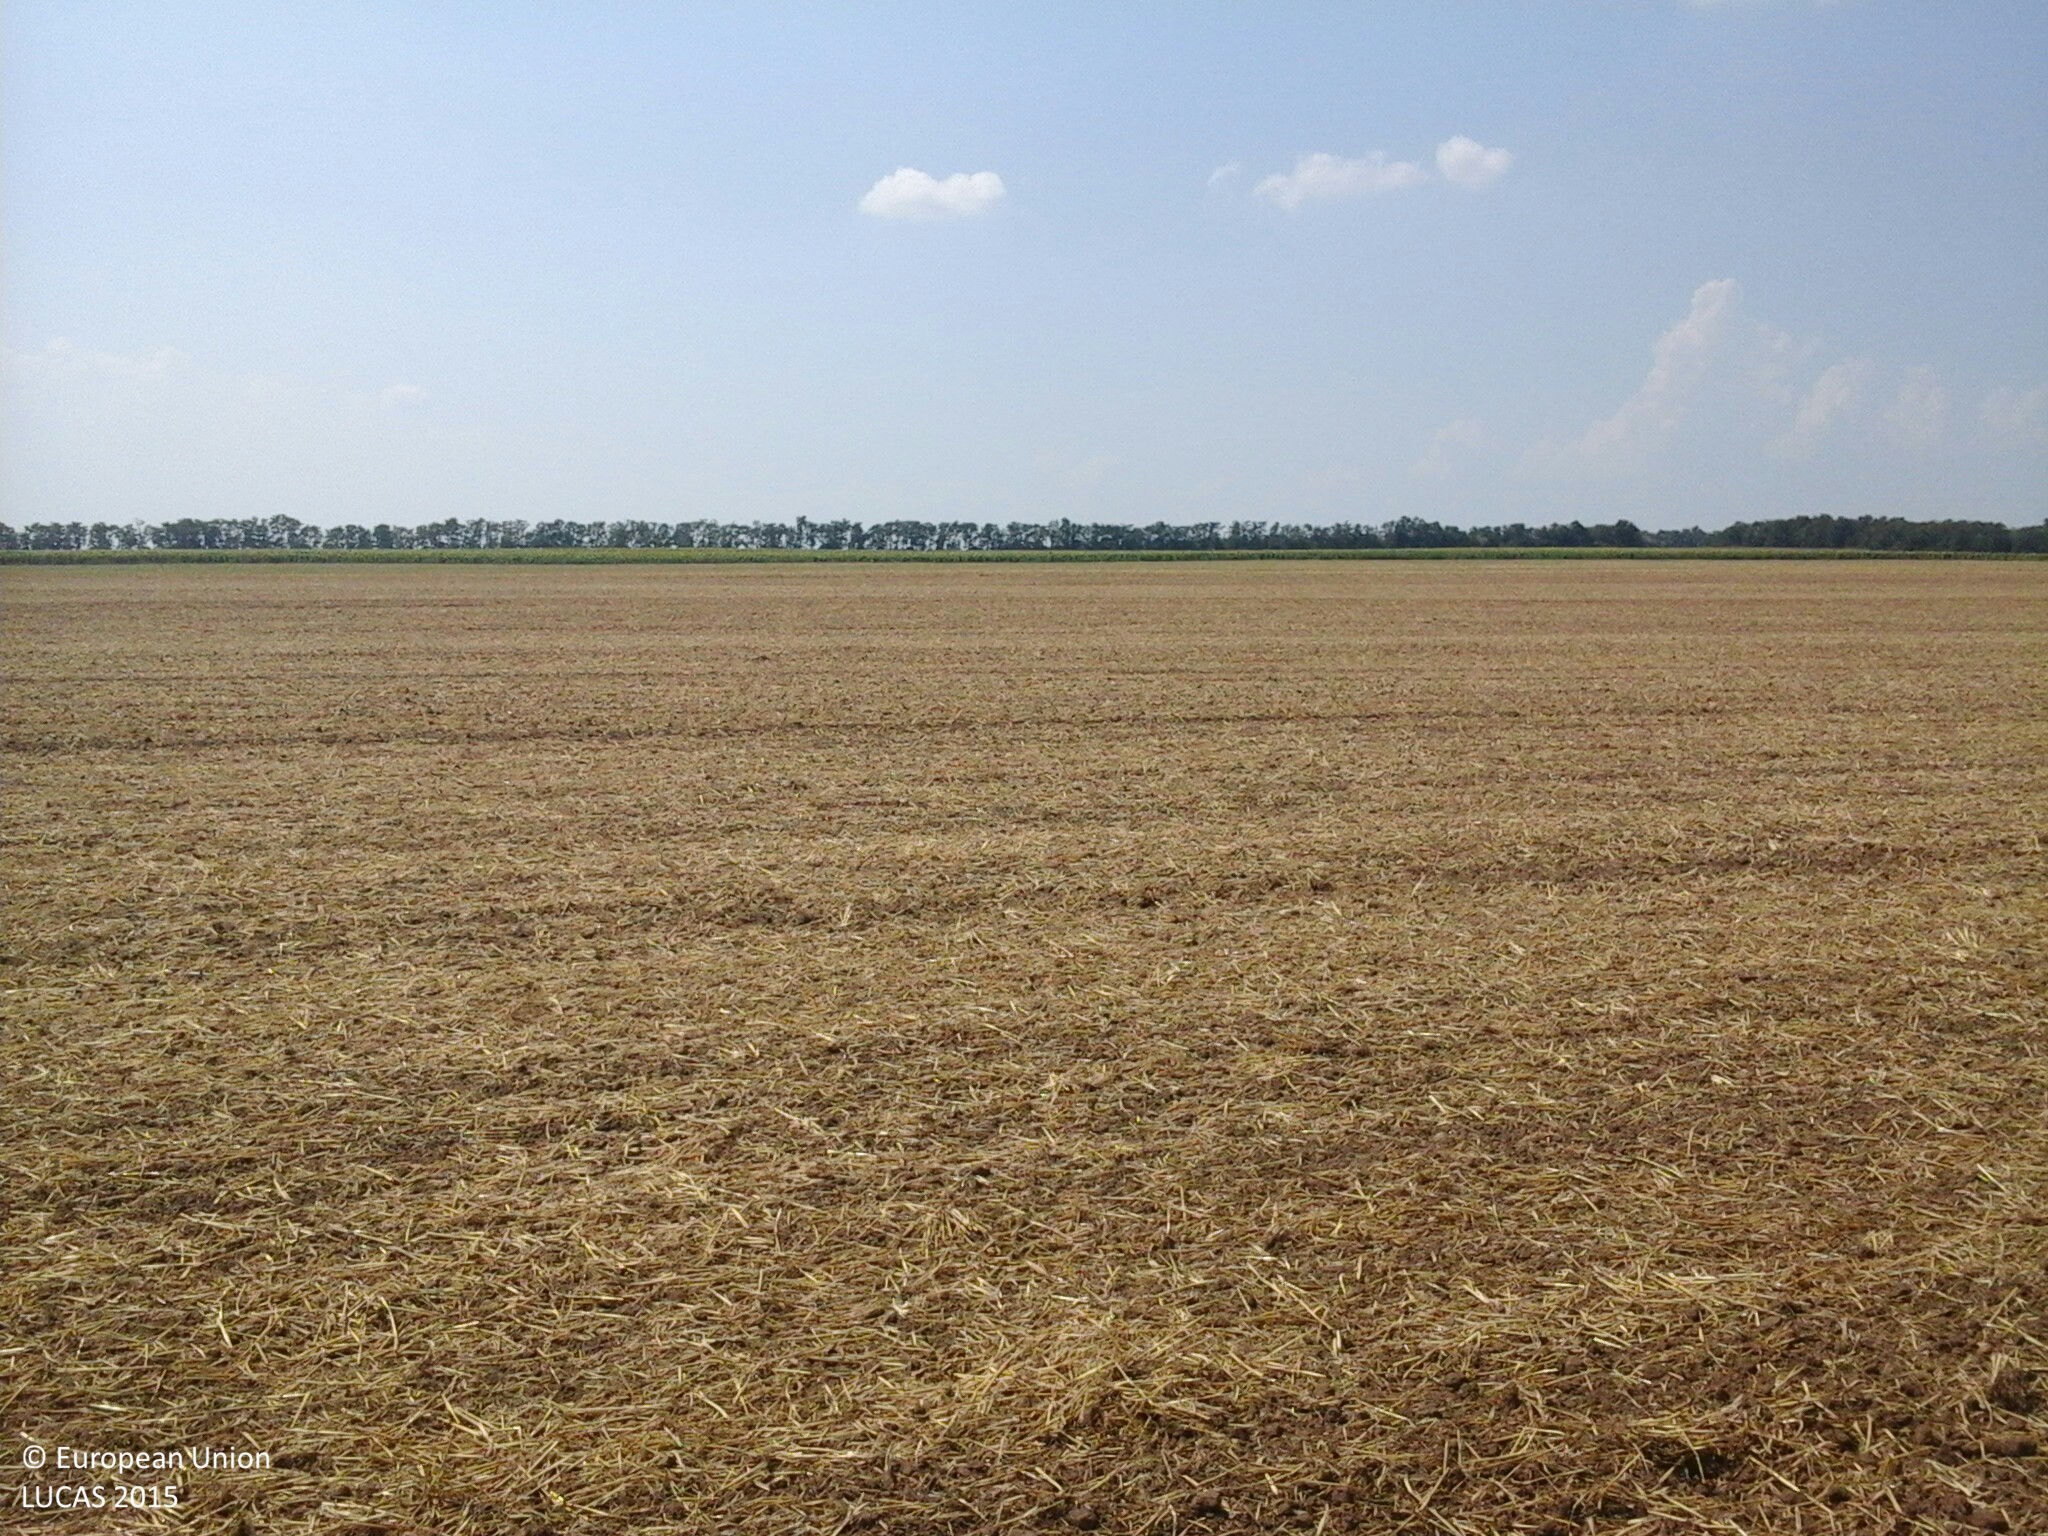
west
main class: Cropland
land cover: Common wheat
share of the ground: < 10 %
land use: Agriculture (excluding fallow land and kitchen gardens)
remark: Harvested field
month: August
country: HU
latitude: 46.8756
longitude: 18.3424
